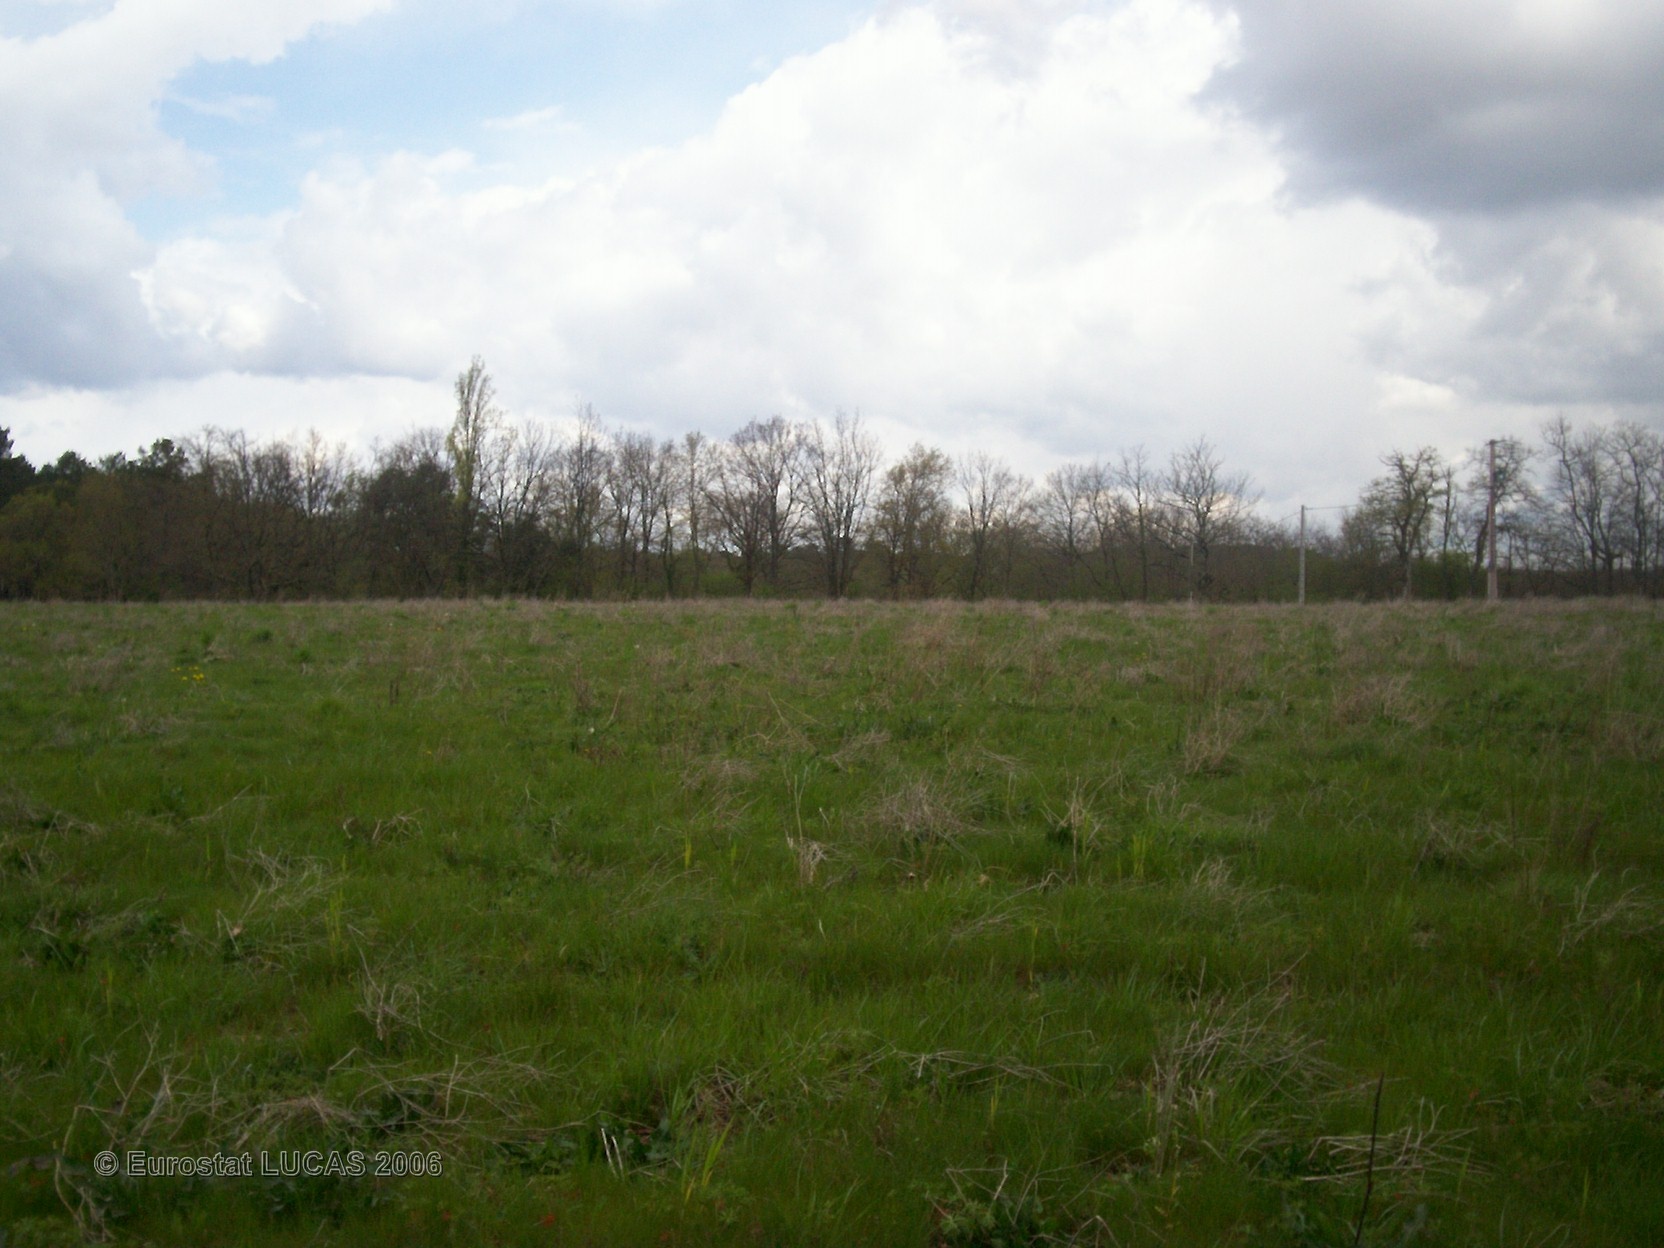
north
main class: Grassland
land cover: Grassland with sparse tree/shrub cover
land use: Agriculture (excluding fallow land and kitchen gardens)
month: April
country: FR
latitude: 43.9903
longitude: 0.1548
